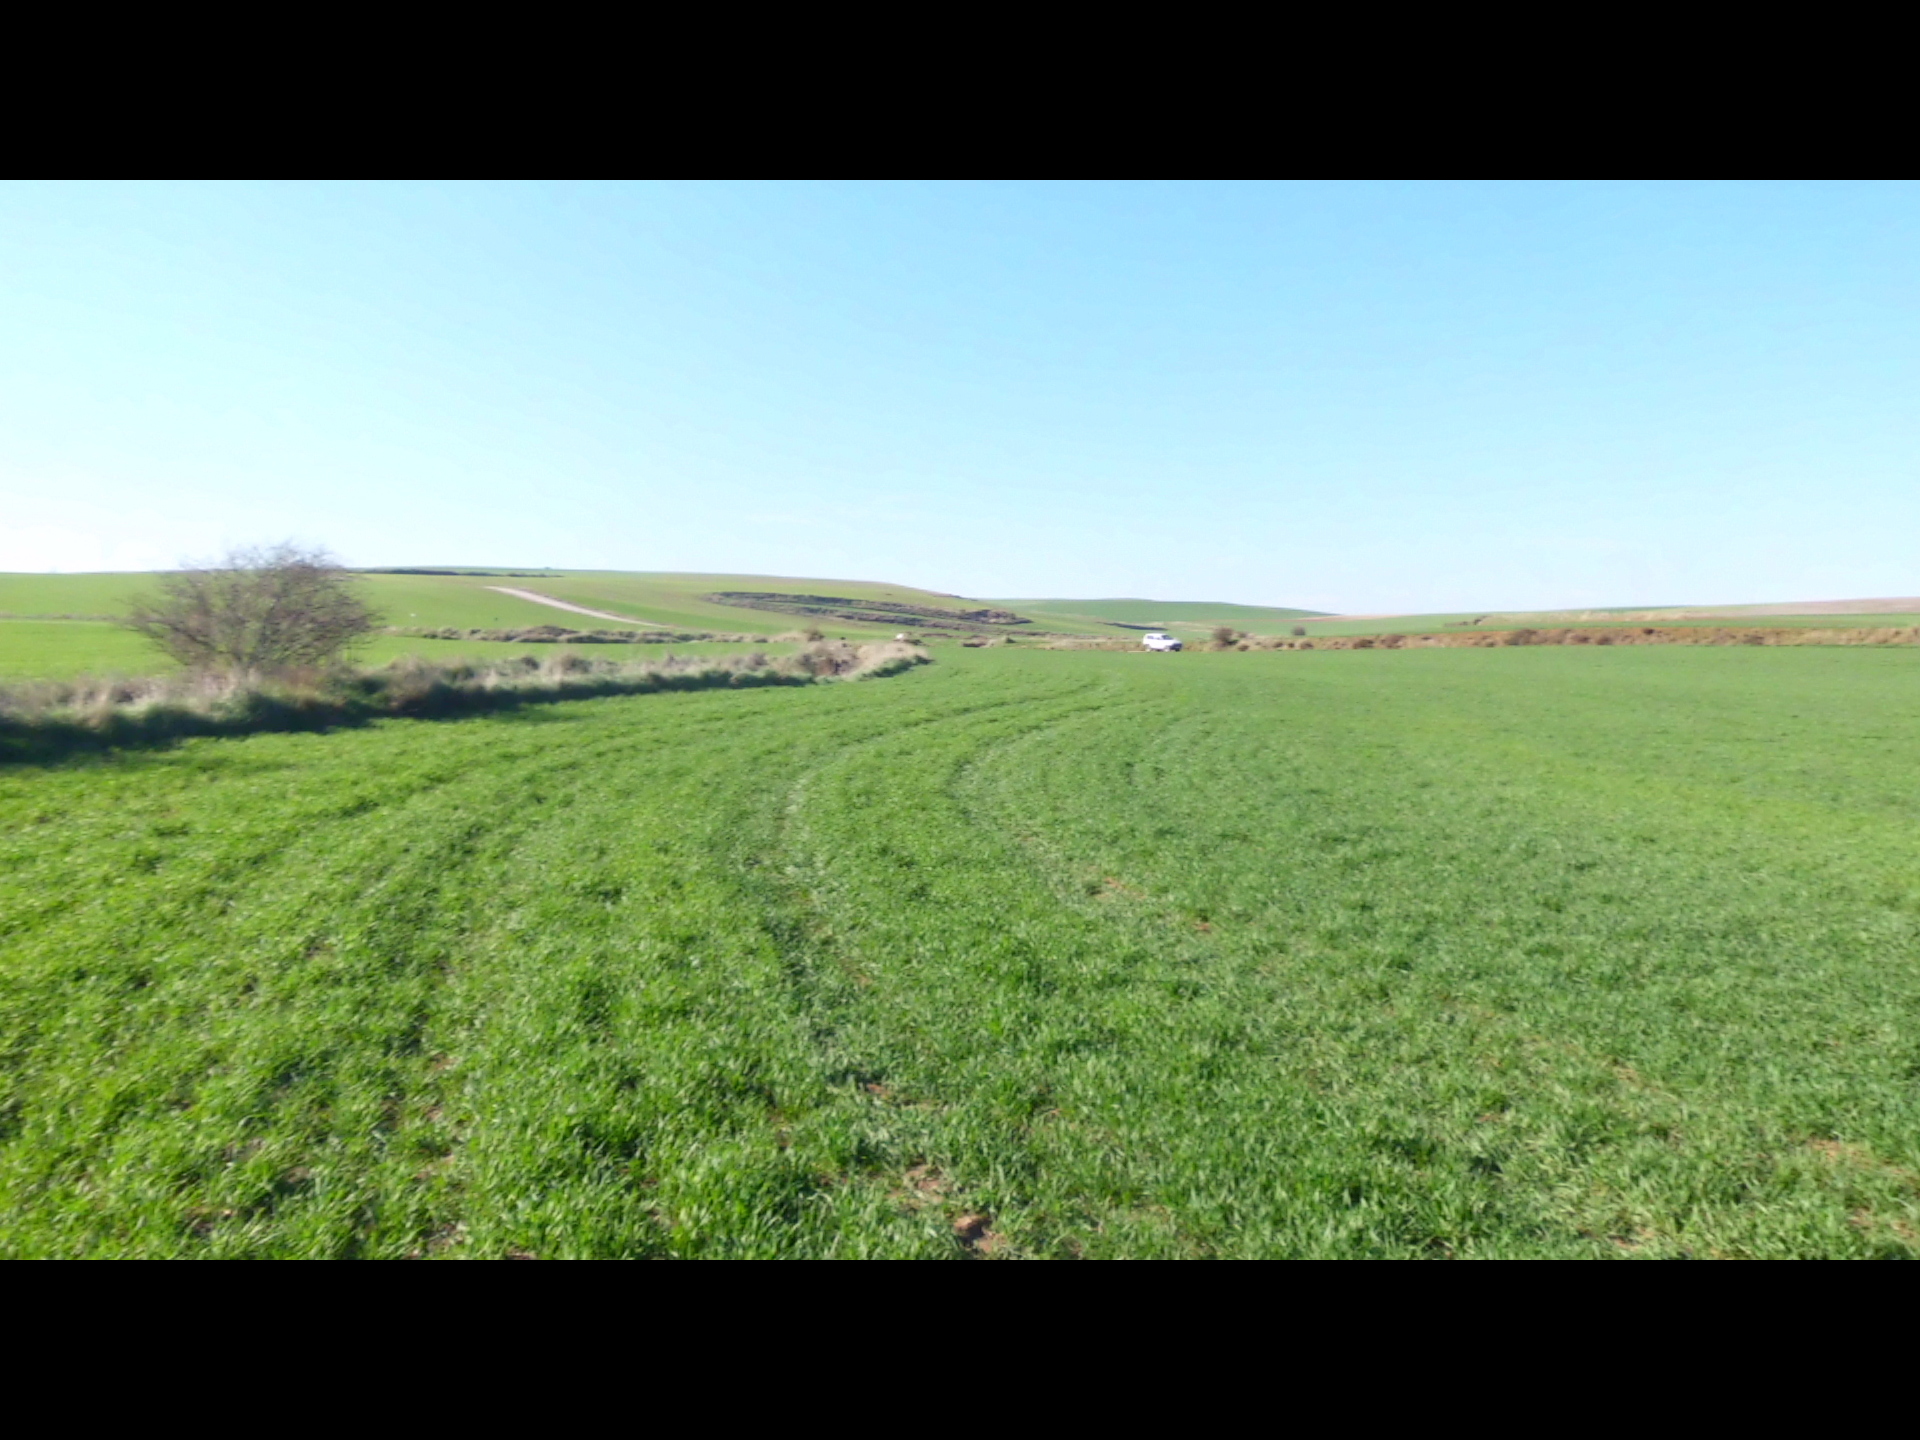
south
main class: Cropland
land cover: Common wheat
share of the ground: > 75 %
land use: Agriculture (excluding fallow land and kitchen gardens)
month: April
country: ES
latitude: 42.2651
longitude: -3.8460
